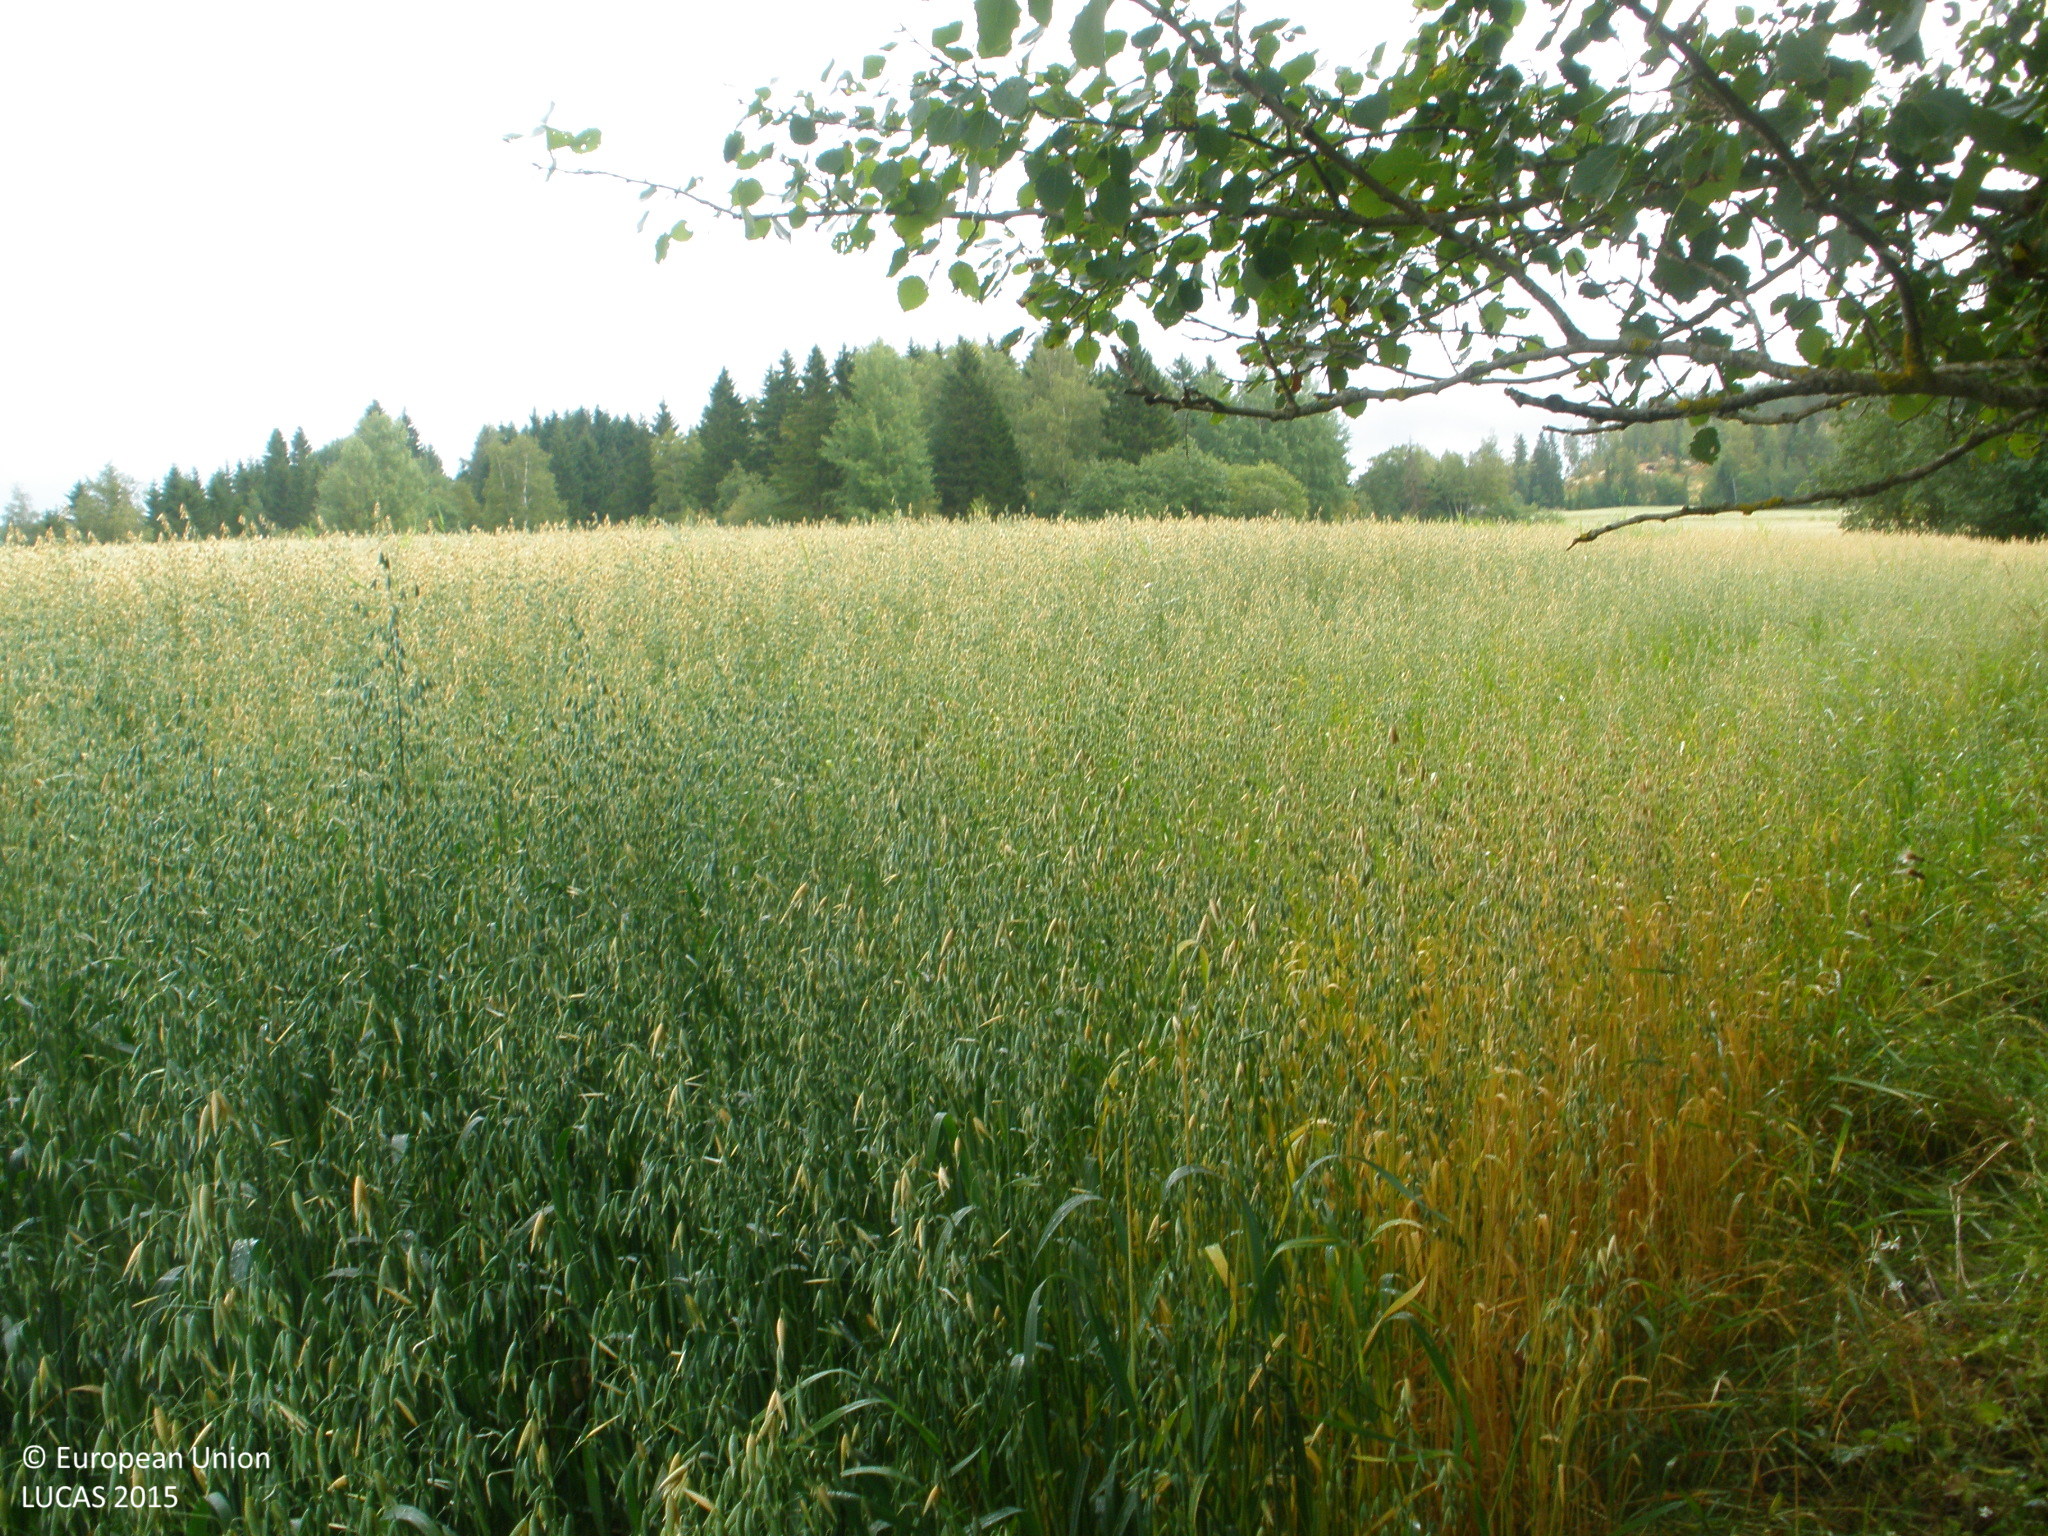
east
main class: Cropland
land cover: Oats
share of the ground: > 75 %
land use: Agriculture (excluding fallow land and kitchen gardens)
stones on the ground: < 10 %
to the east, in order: Oats; Spruce dominated mixed woodland
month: August
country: FI
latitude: 60.4868
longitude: 23.4246
